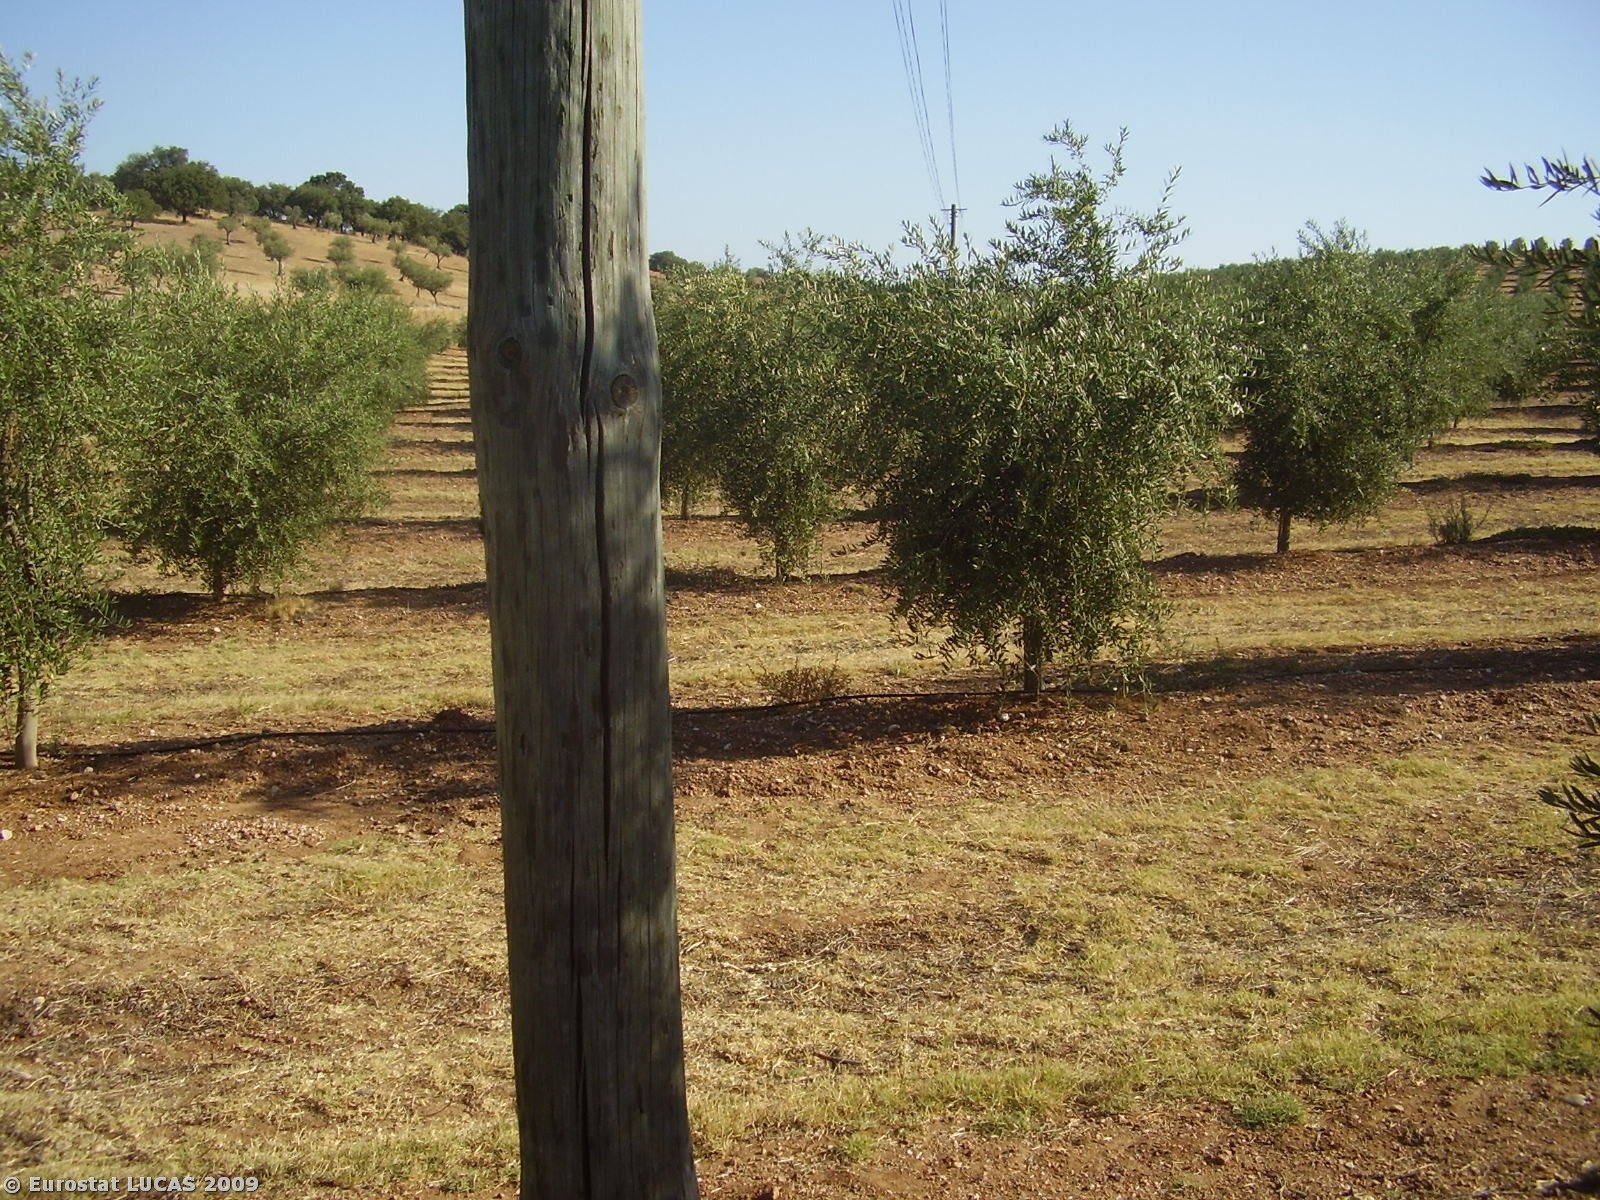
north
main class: Cropland
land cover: Olive groves
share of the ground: 10 - 25 %
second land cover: Spontaneously vegetated surfaces
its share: 50 - 75 %
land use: Agriculture (excluding fallow land and kitchen gardens)
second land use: Fallow land
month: August
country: PT
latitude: 38.0864
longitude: -7.6157
